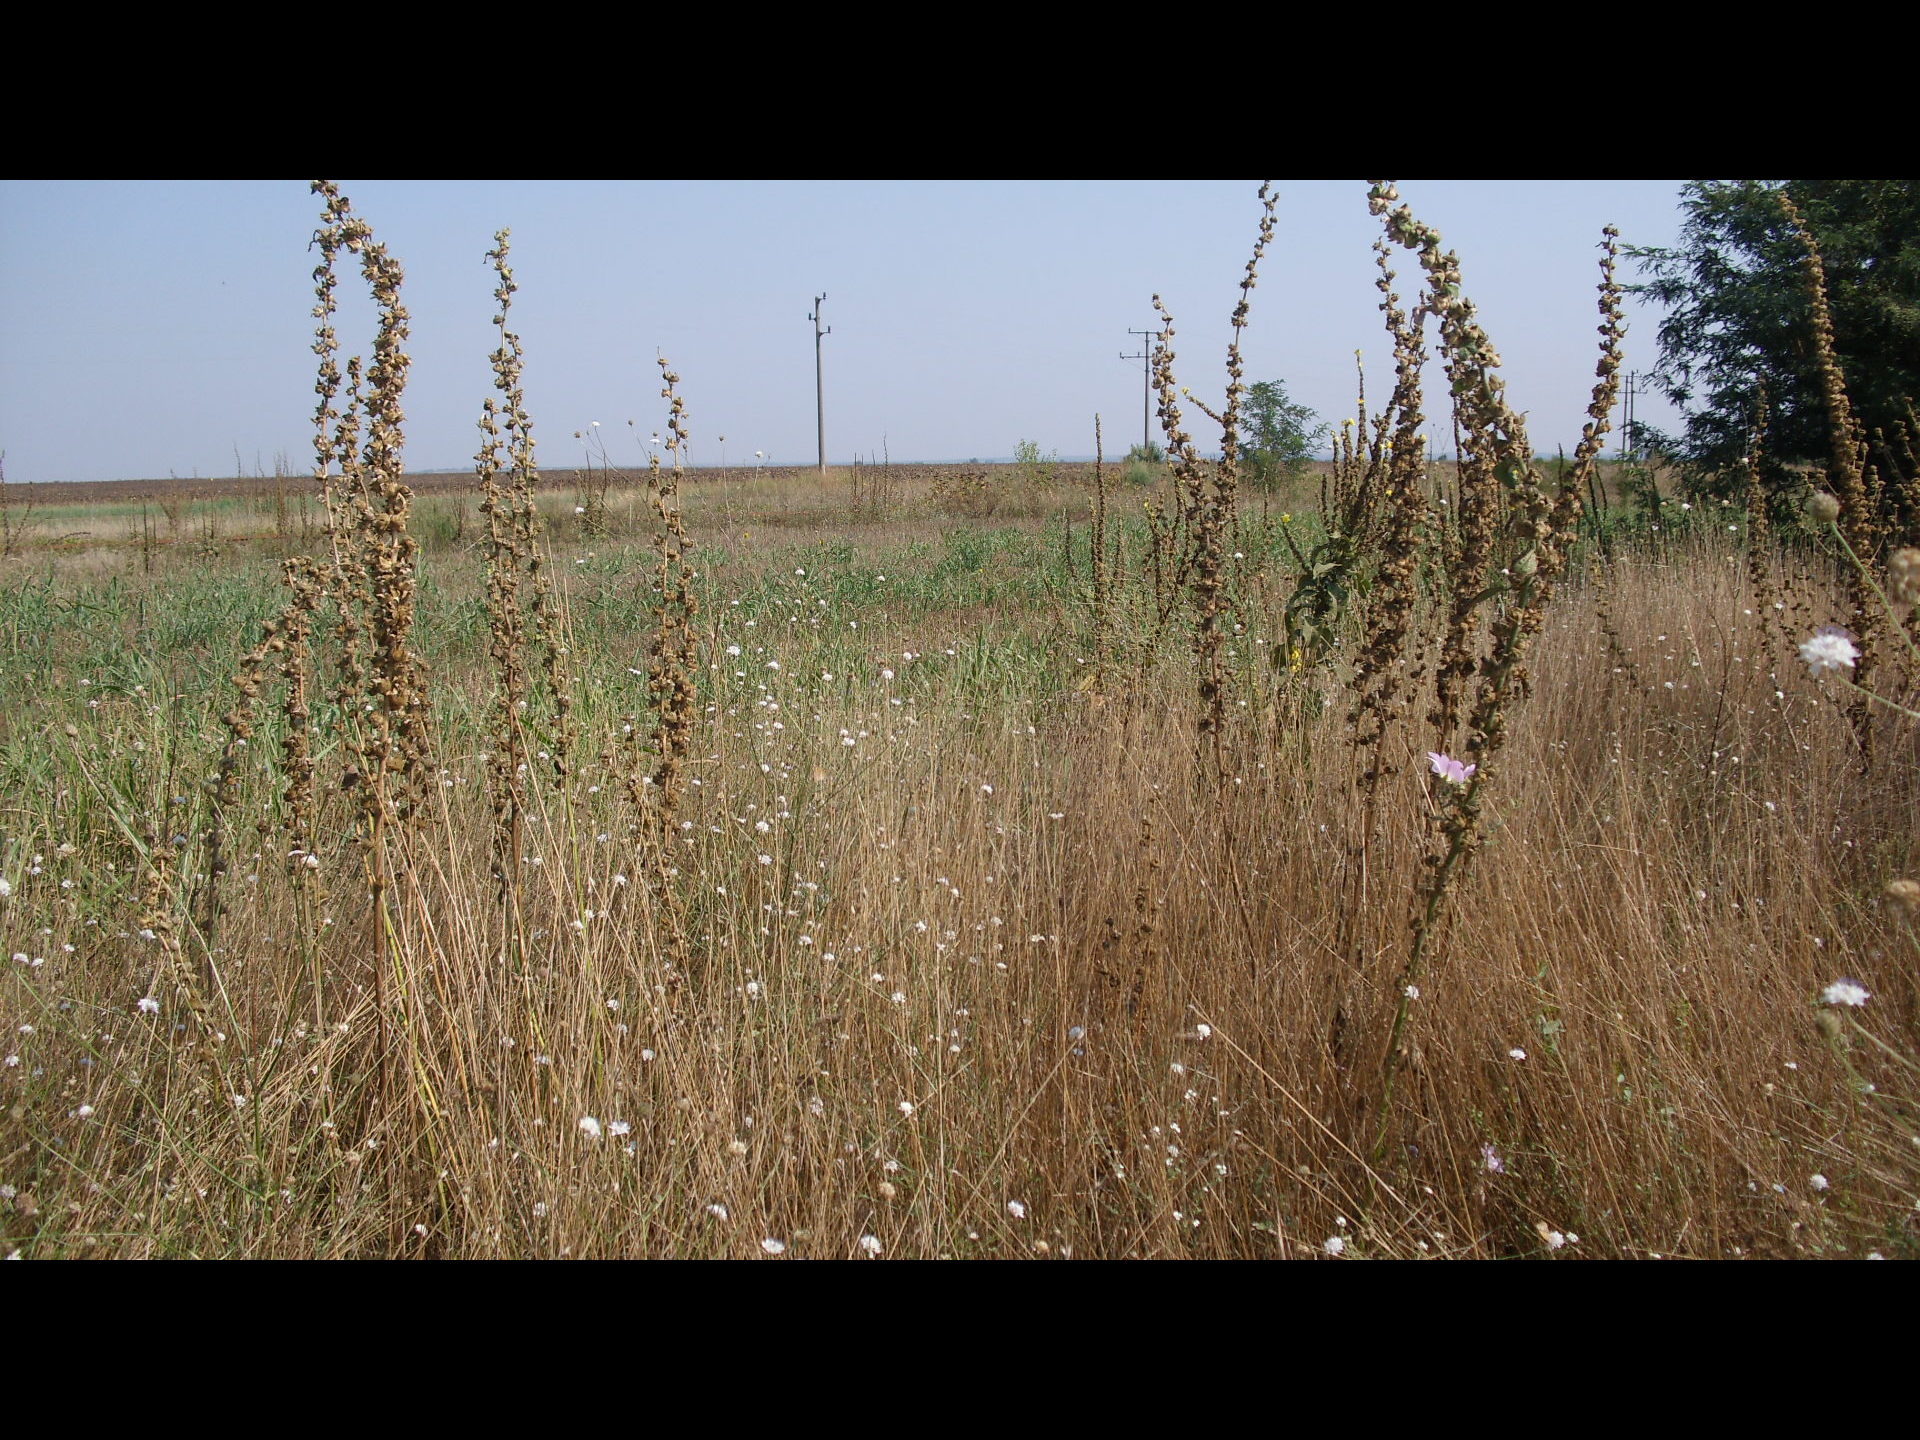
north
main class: Grassland
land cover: Grassland with sparse tree/shrub cover
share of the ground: > 75 %
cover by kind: herbaceous plants 95 %, broadleaved forest trees 5 %
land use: Agriculture (excluding fallow land and kitchen gardens)
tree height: < 5 m
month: August
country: BG
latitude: 44.0420
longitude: 22.9830
